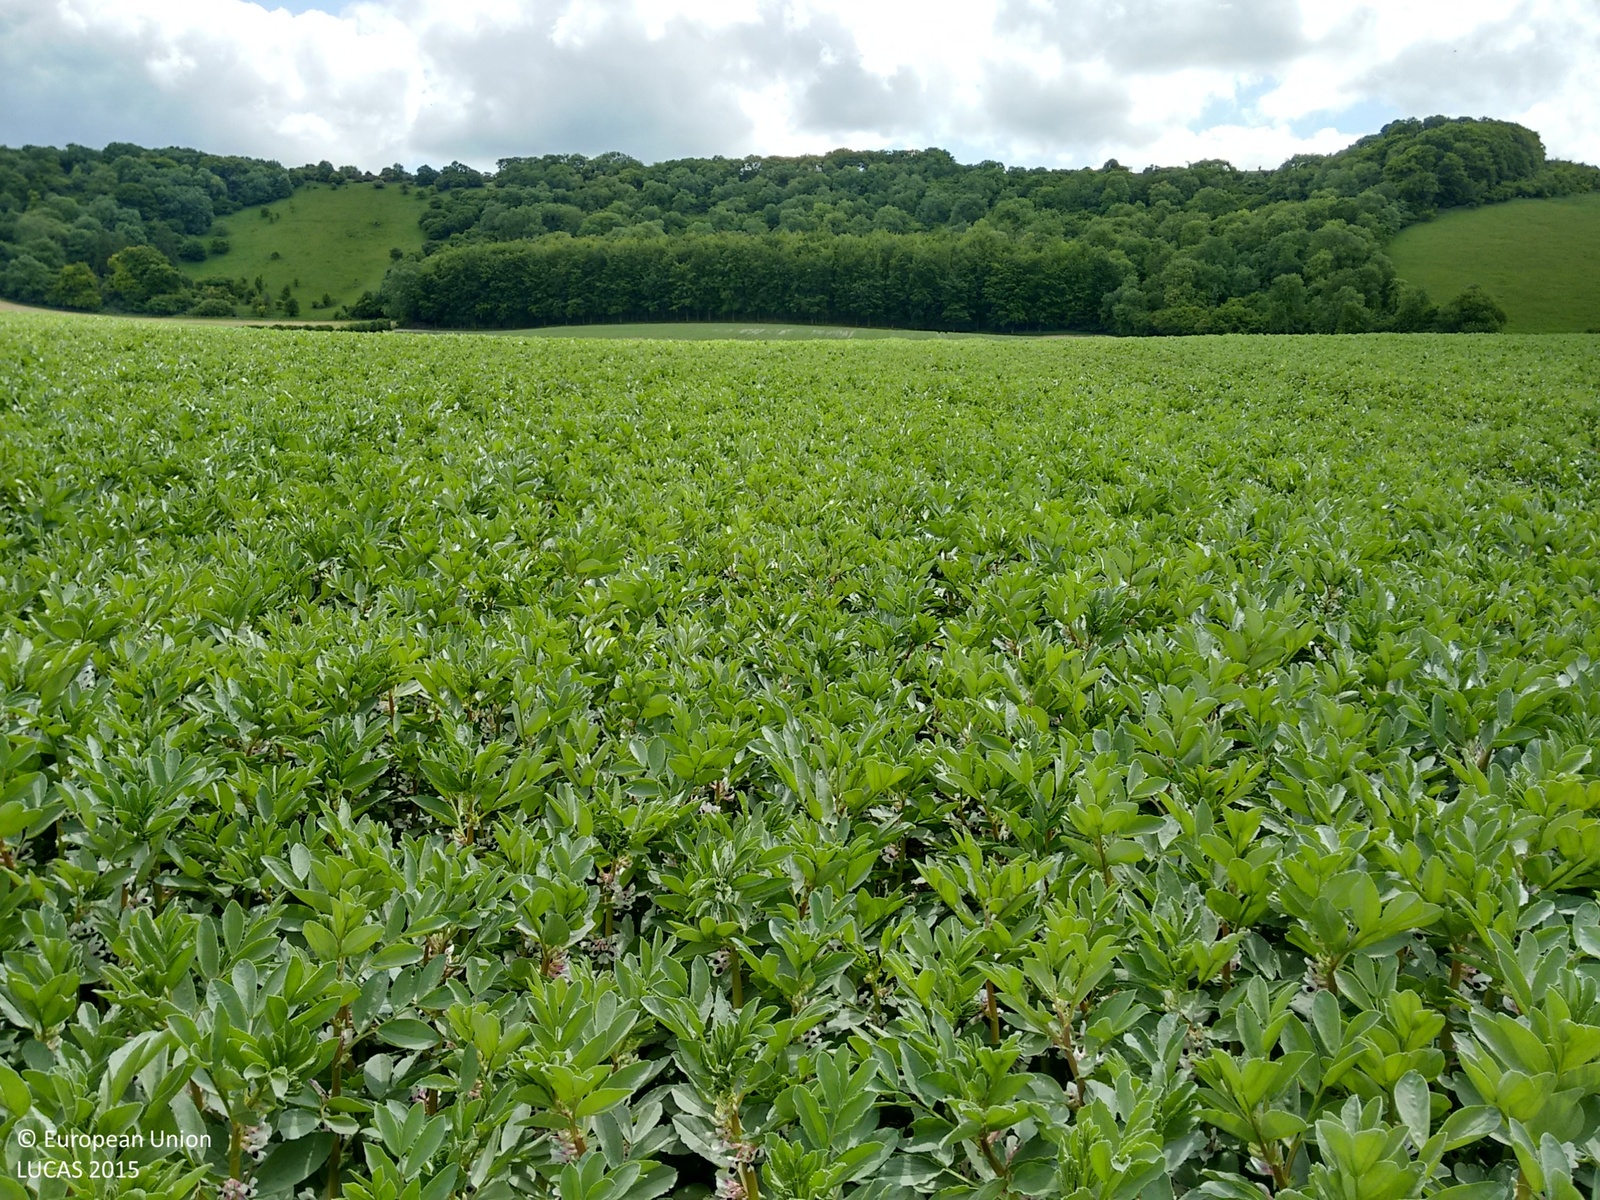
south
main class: Cropland
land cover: Dry pulses
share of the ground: > 75 %
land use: Agriculture (excluding fallow land and kitchen gardens)
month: June
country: GB
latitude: 51.3625
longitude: -1.4978
